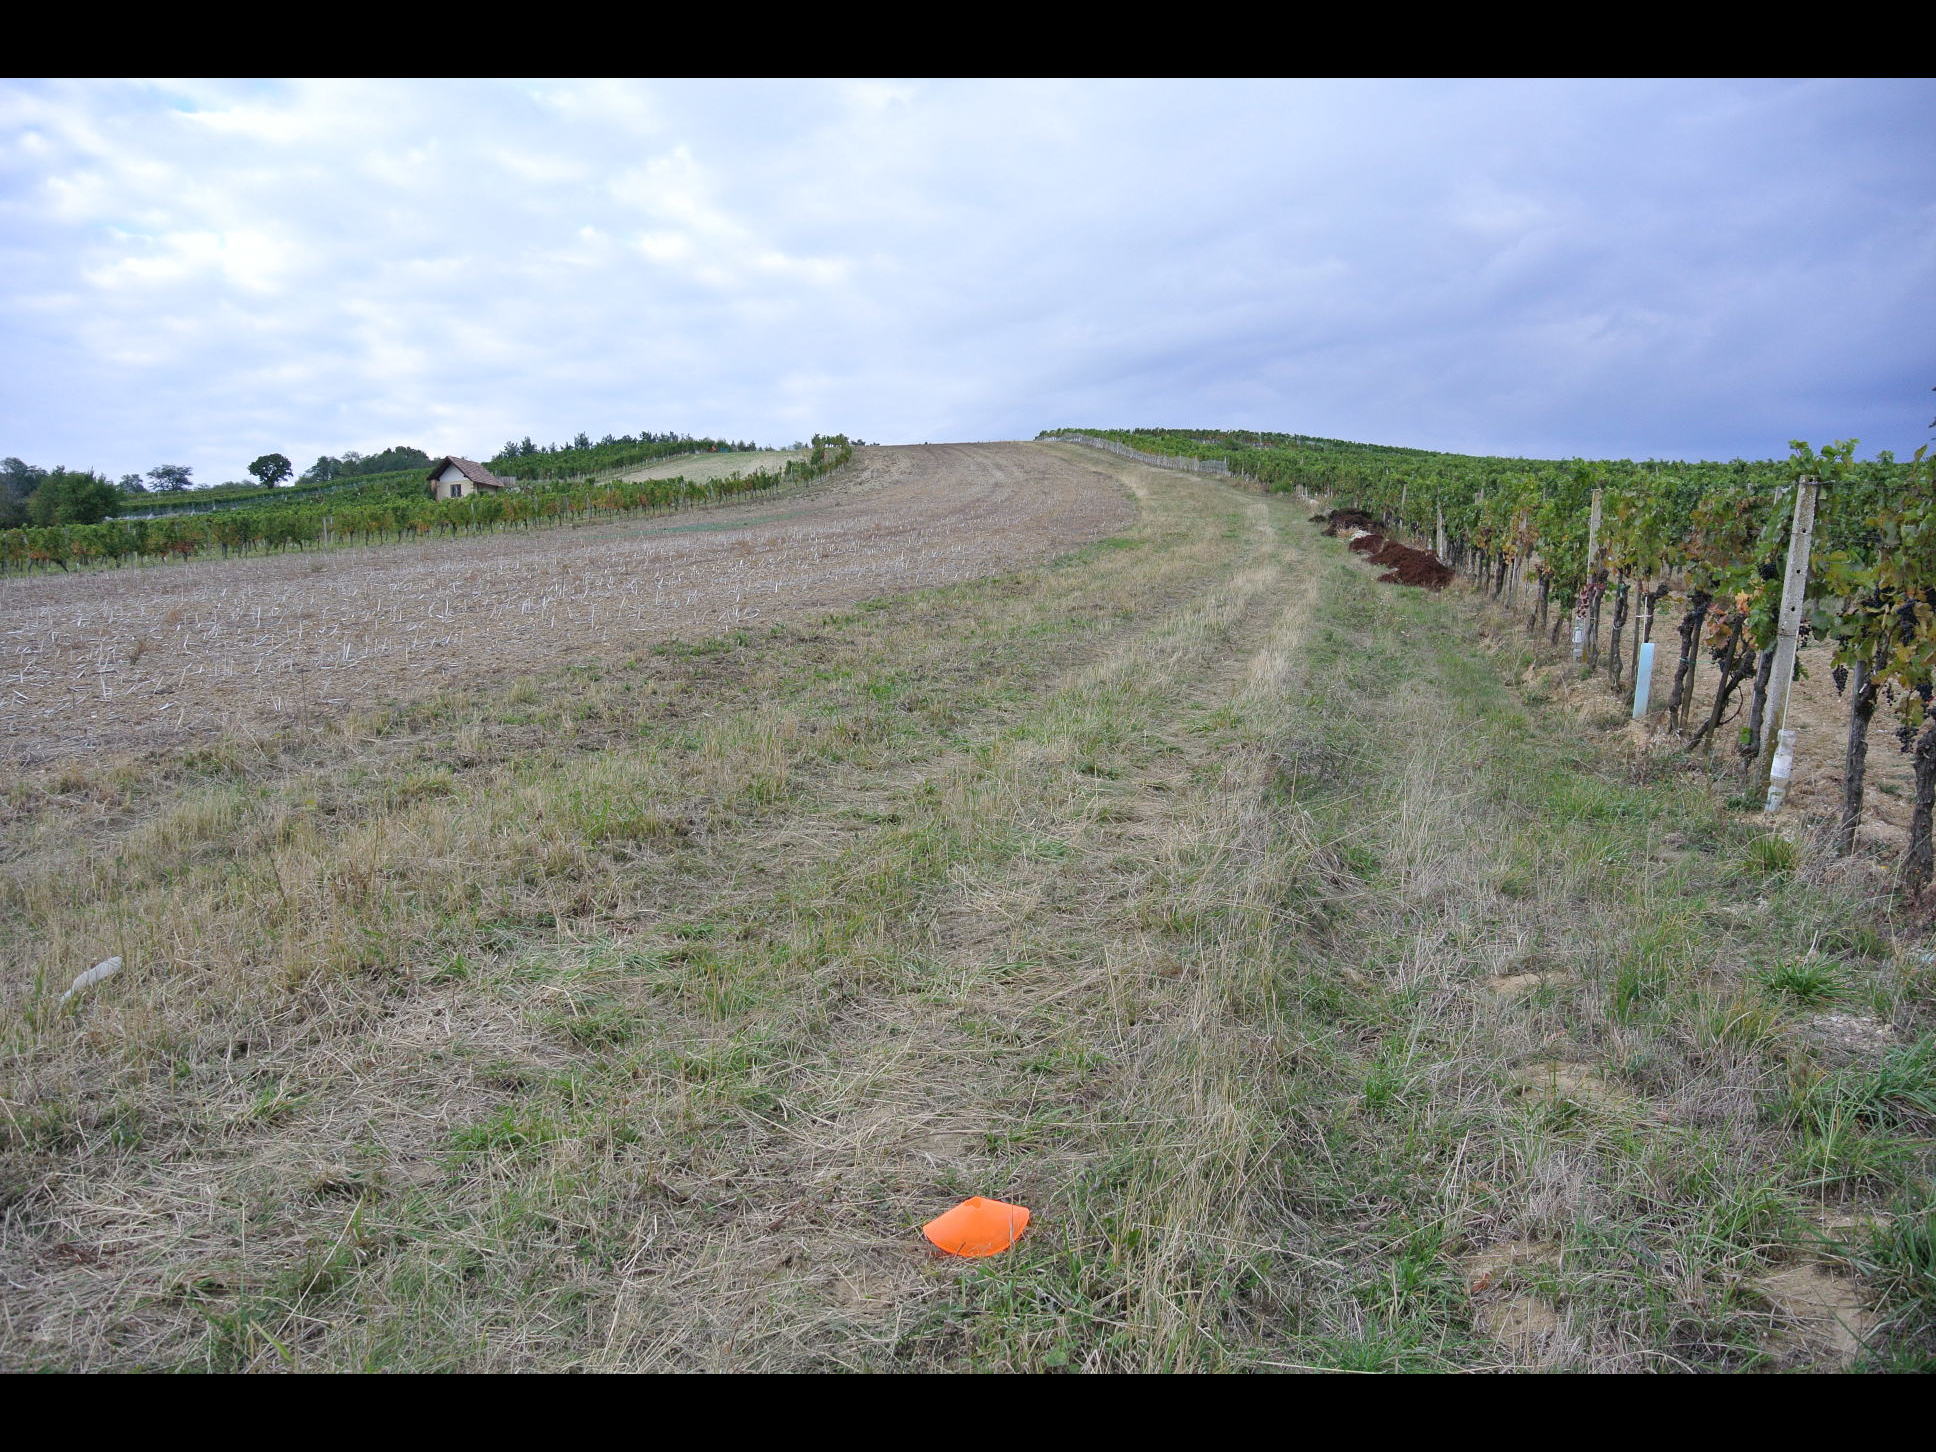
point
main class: Grassland
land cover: Grassland without tree/shrub cover
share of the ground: > 75 %
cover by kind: herbaceous plants 100 %
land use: Agriculture (excluding fallow land and kitchen gardens)
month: September
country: AT
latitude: 47.6143
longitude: 16.5365
